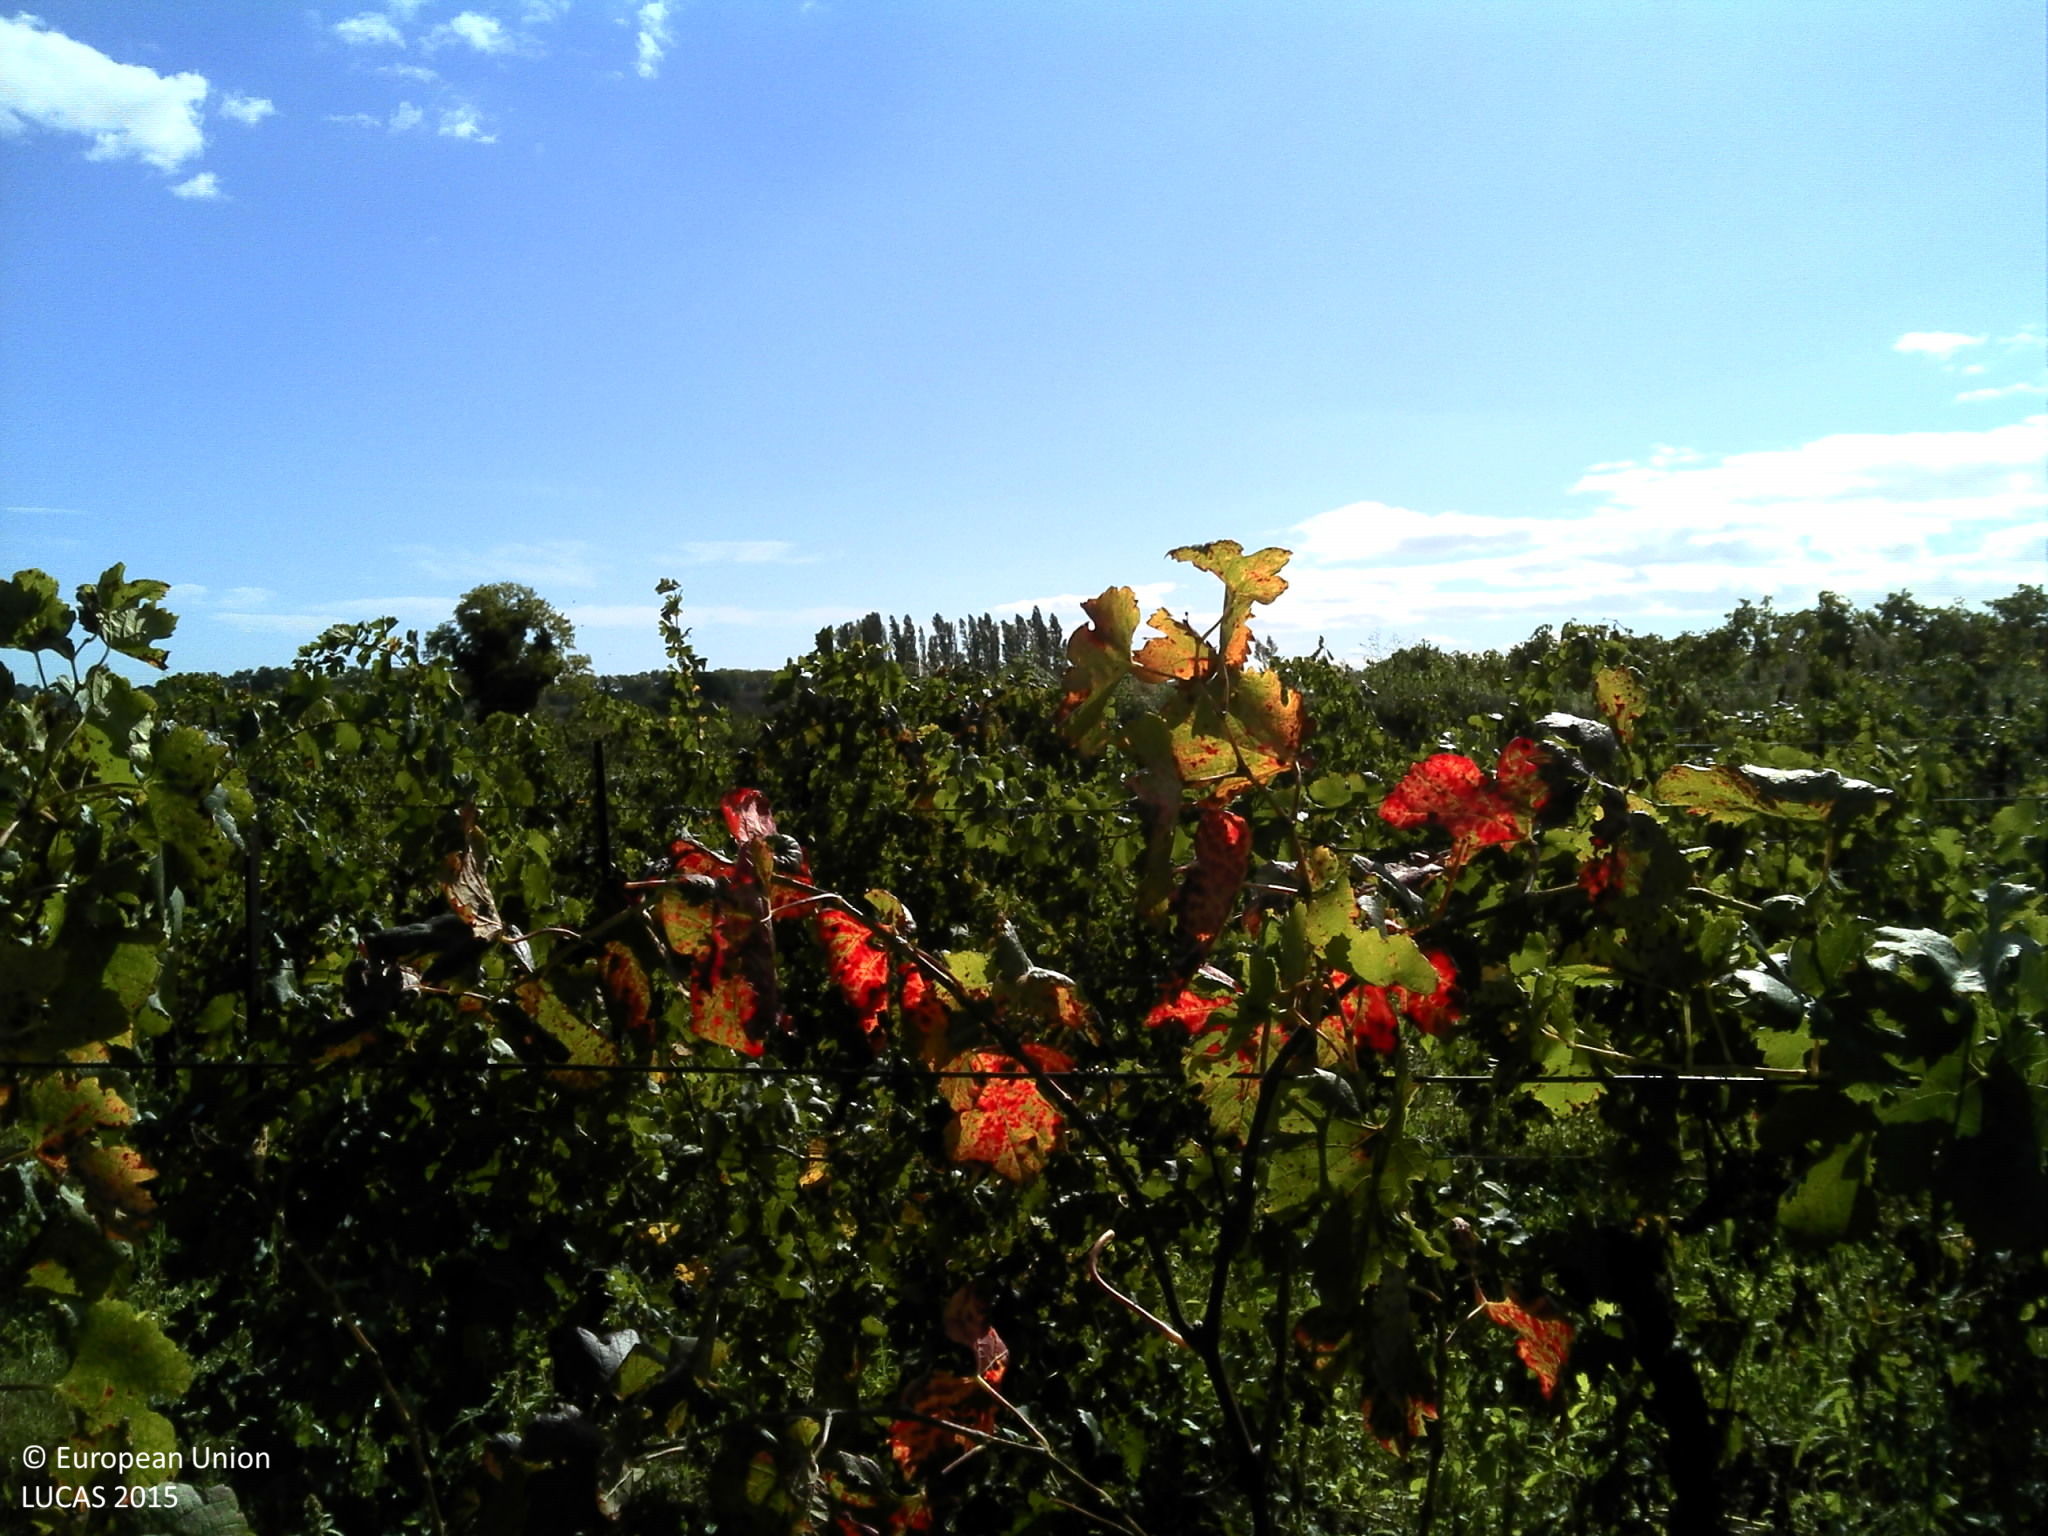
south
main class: Cropland
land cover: Vineyards
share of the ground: 10 - 25 %
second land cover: Spontaneously vegetated surfaces
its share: > 75 %
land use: Agriculture (excluding fallow land and kitchen gardens)
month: October
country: FR
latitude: 43.4526
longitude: 3.3978
